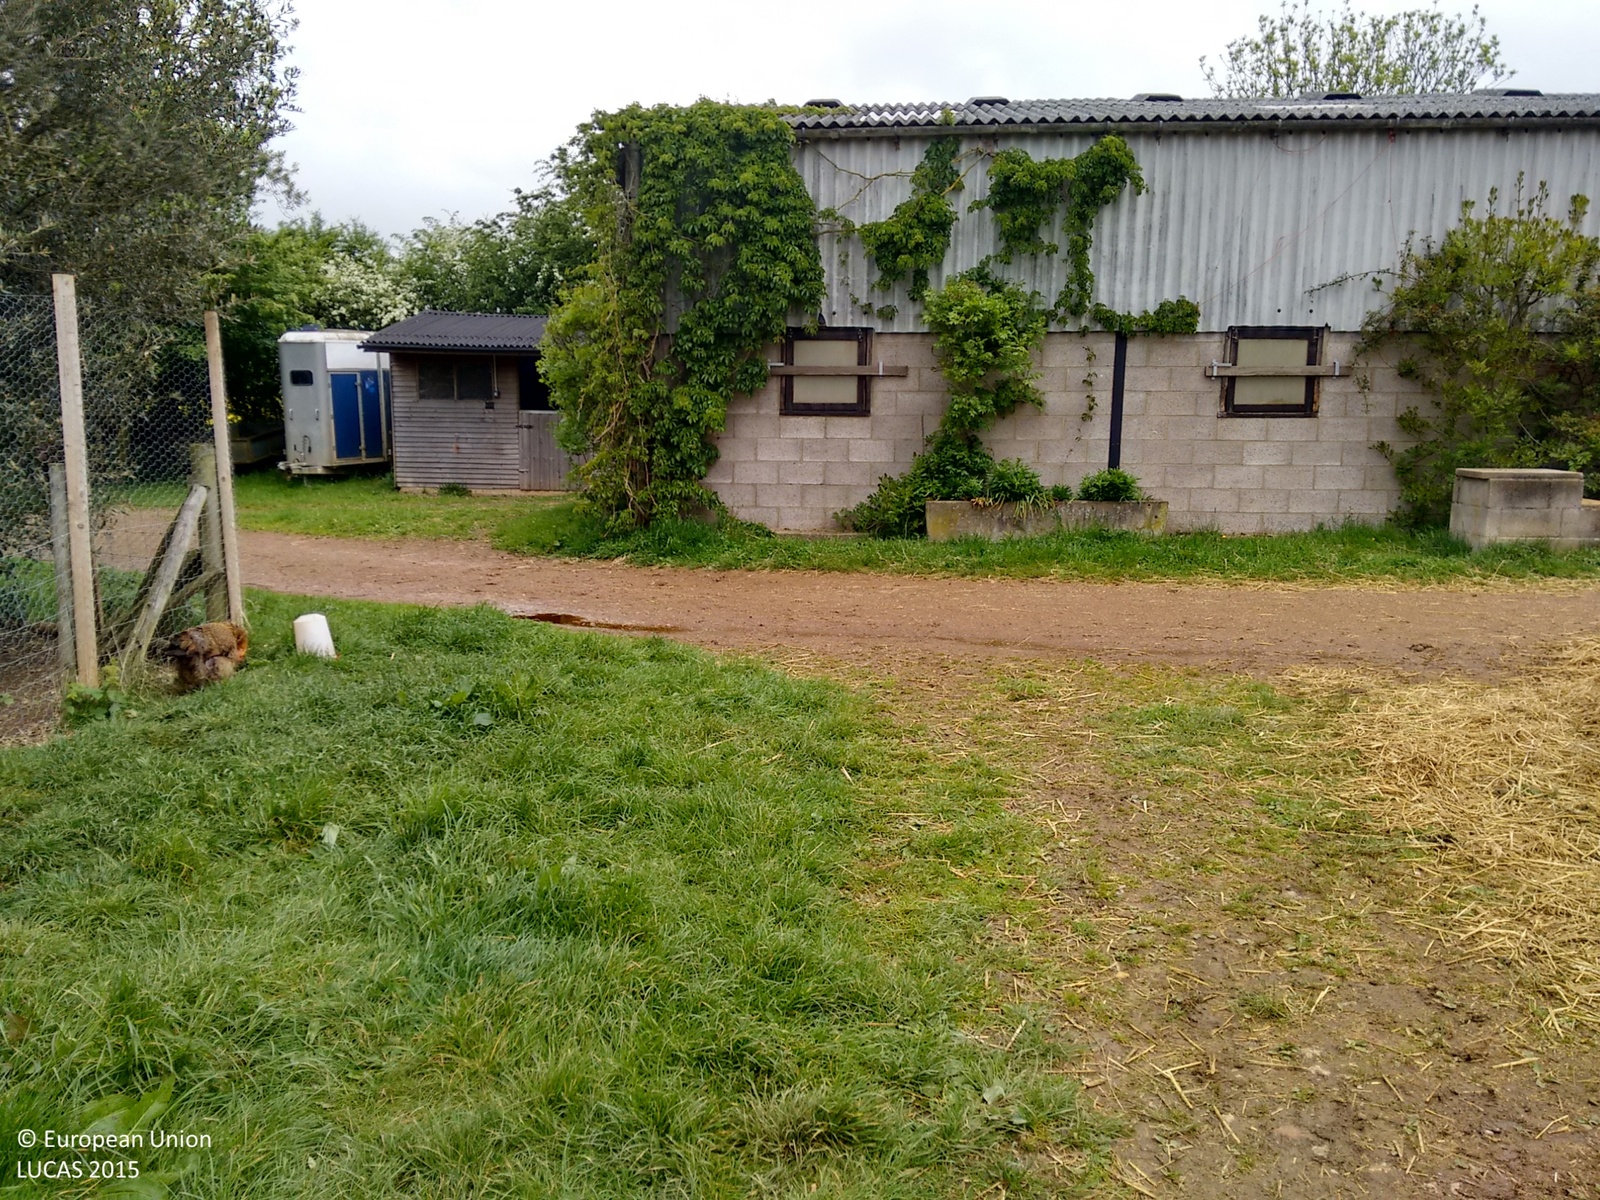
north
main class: Grassland
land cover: Grassland without tree/shrub cover
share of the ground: > 75 %
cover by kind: herbaceous plants 100 %
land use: Agriculture (excluding fallow land and kitchen gardens)
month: May
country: GB
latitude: 52.2607
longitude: -1.2262
